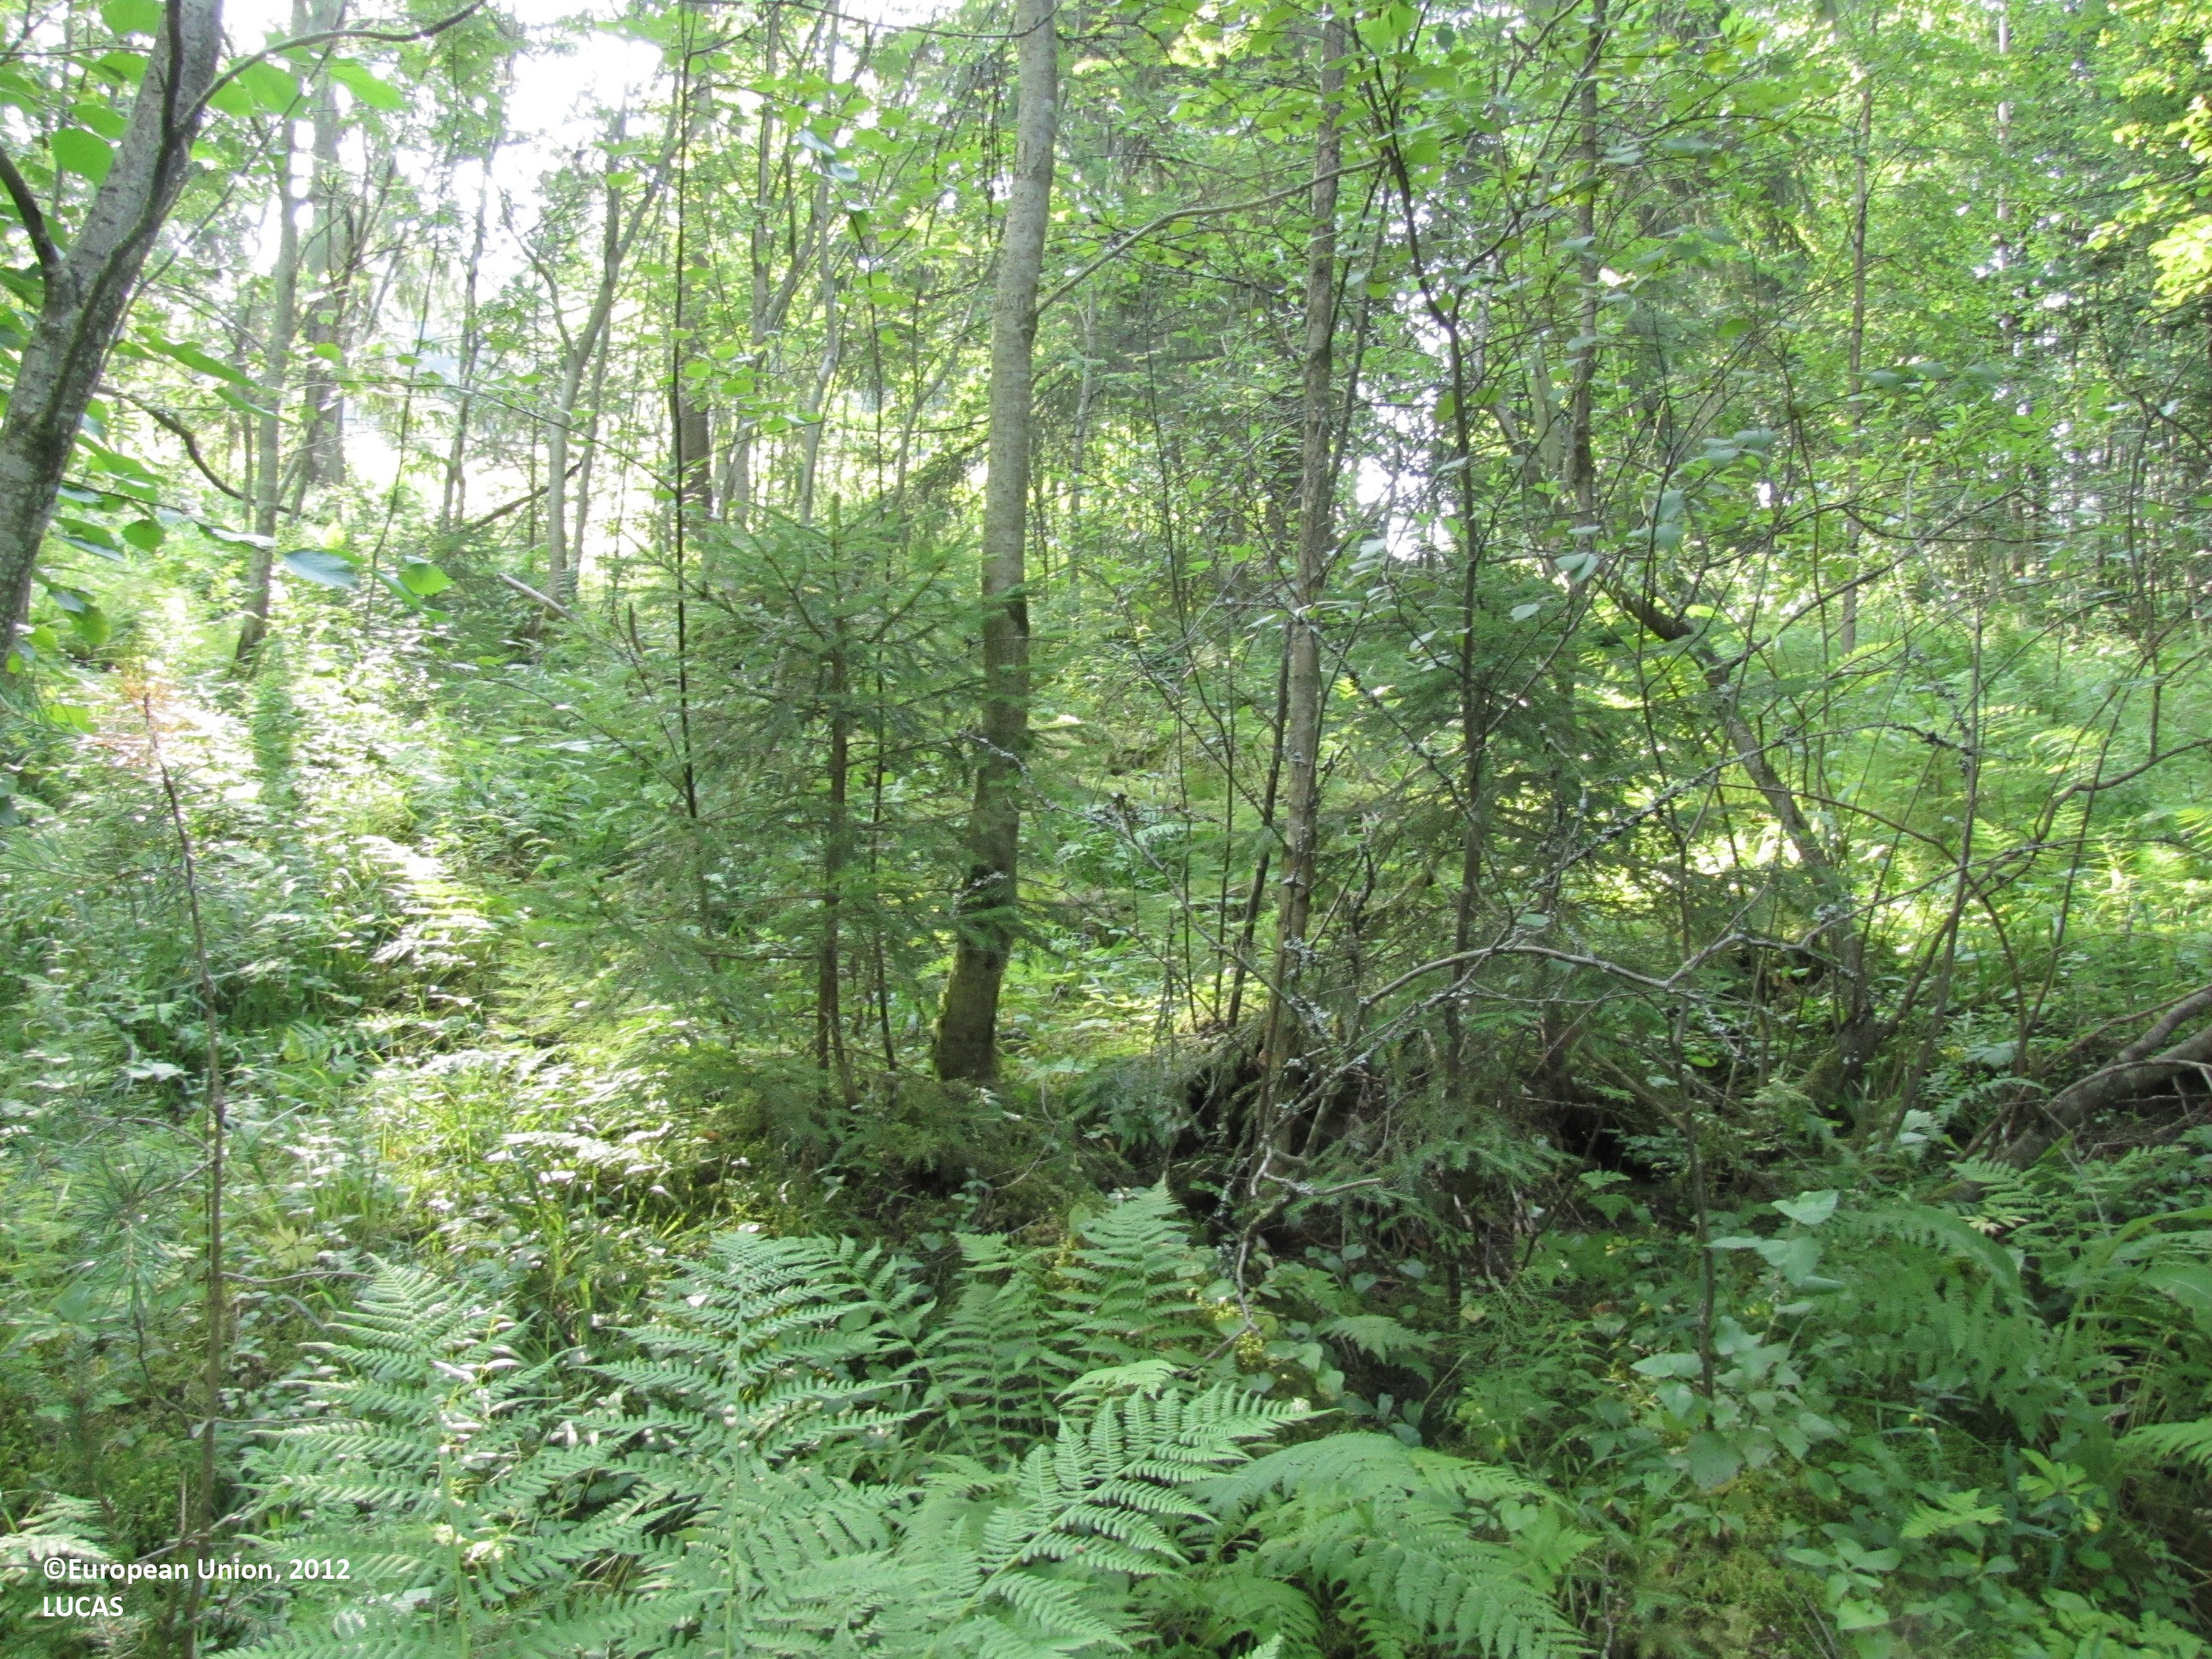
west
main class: Woodland
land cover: Other mixed woodland
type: boreal forest
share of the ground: > 75 %
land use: Forestry
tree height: > 5 m
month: July
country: FI
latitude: 61.9708
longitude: 23.0200
